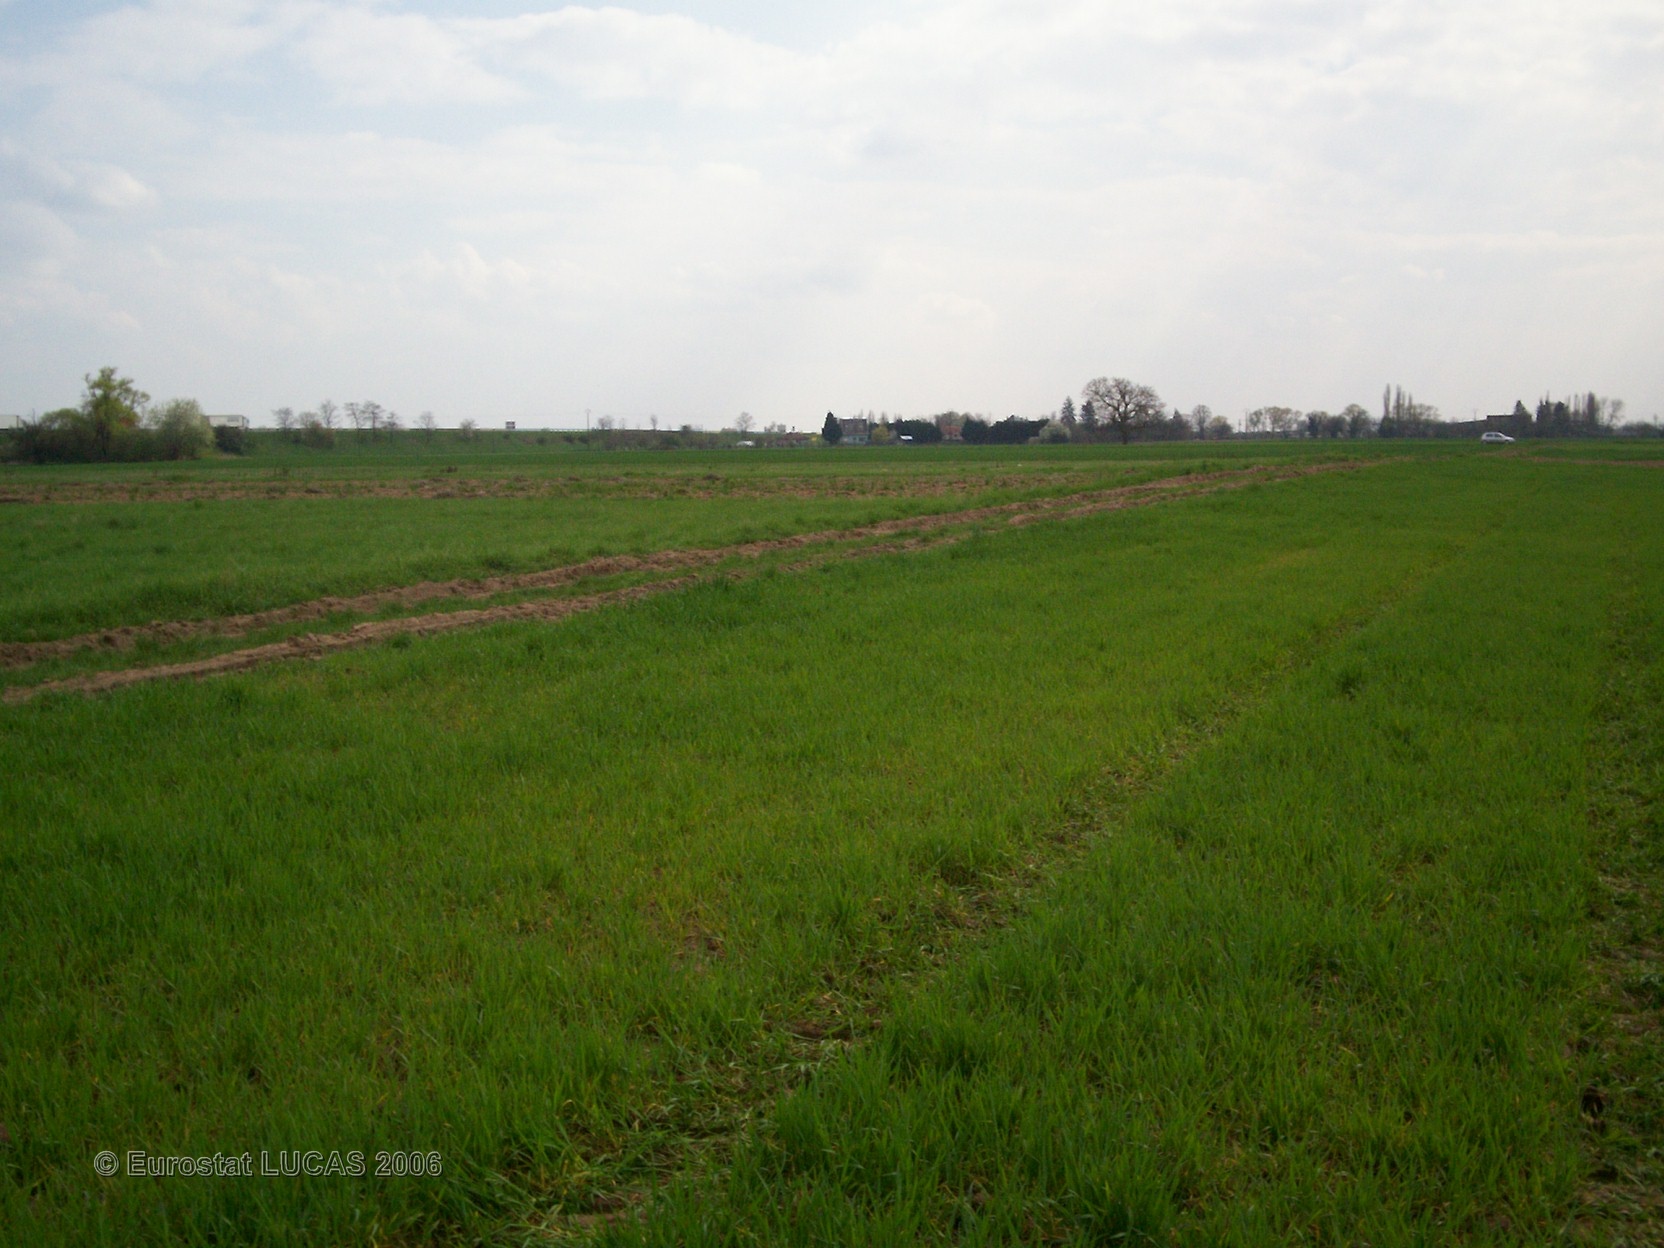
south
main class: Cropland
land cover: Common wheat
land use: Agriculture (excluding fallow land and kitchen gardens)
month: April
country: FR
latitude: 48.2290
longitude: 7.4028
